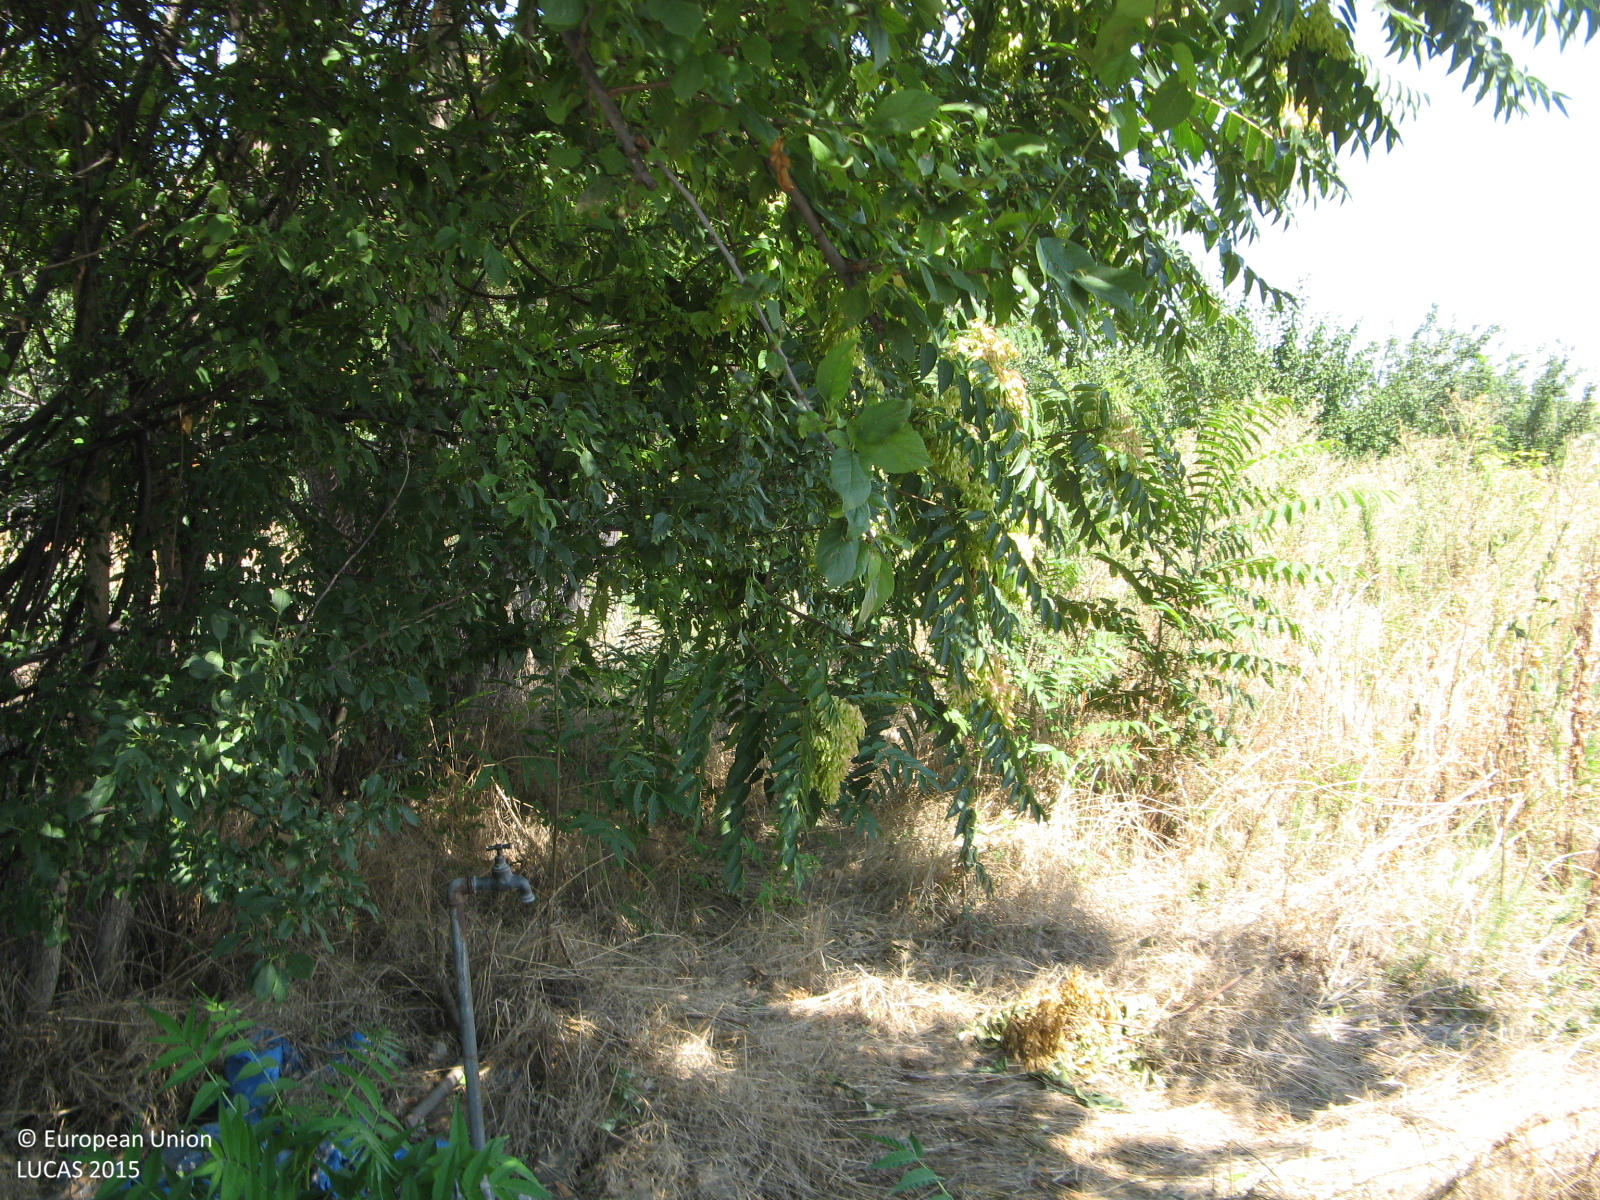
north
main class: Grassland
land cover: Spontaneously vegetated surfaces
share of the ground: > 75 %
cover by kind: herbaceous plants 95 %, shrubs 5 %
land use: Abandoned areas
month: August
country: BG
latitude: 43.5112
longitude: 25.3553
